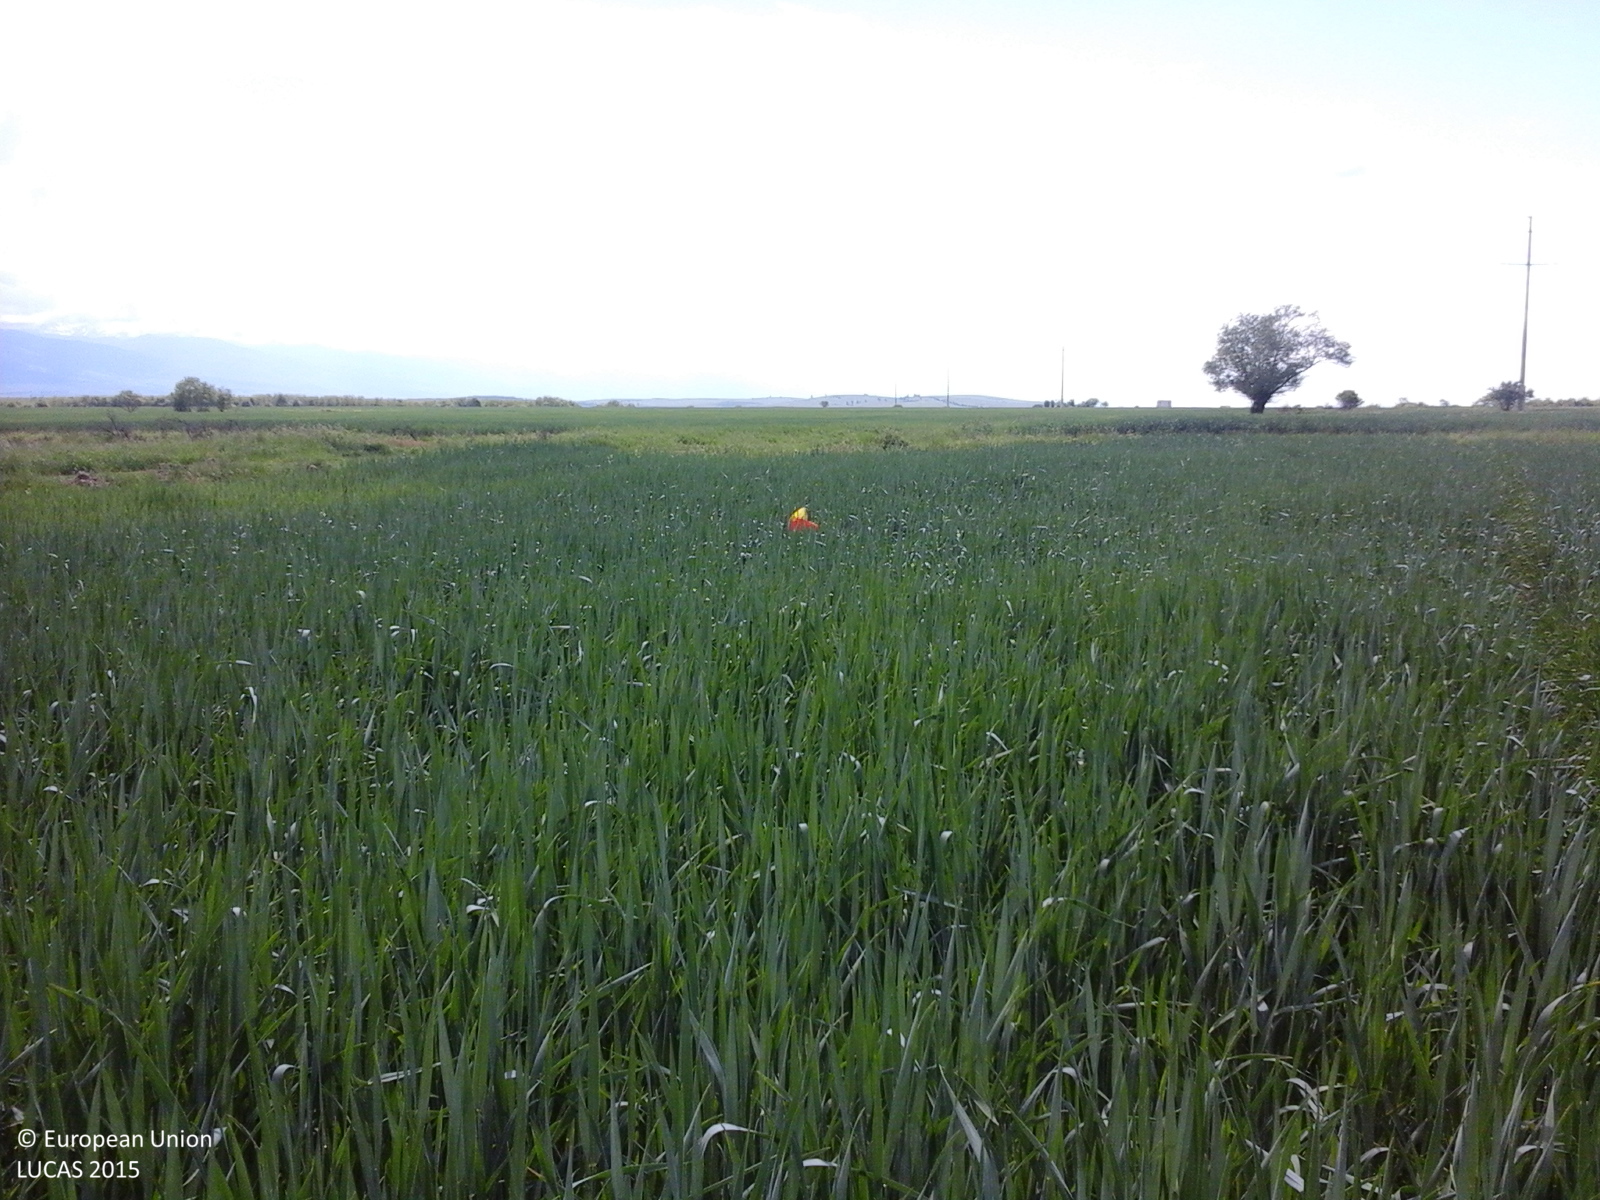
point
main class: Cropland
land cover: Rye
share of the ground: > 75 %
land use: Agriculture (excluding fallow land and kitchen gardens)
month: May
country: RO
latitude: 45.8291
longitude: 25.1702
